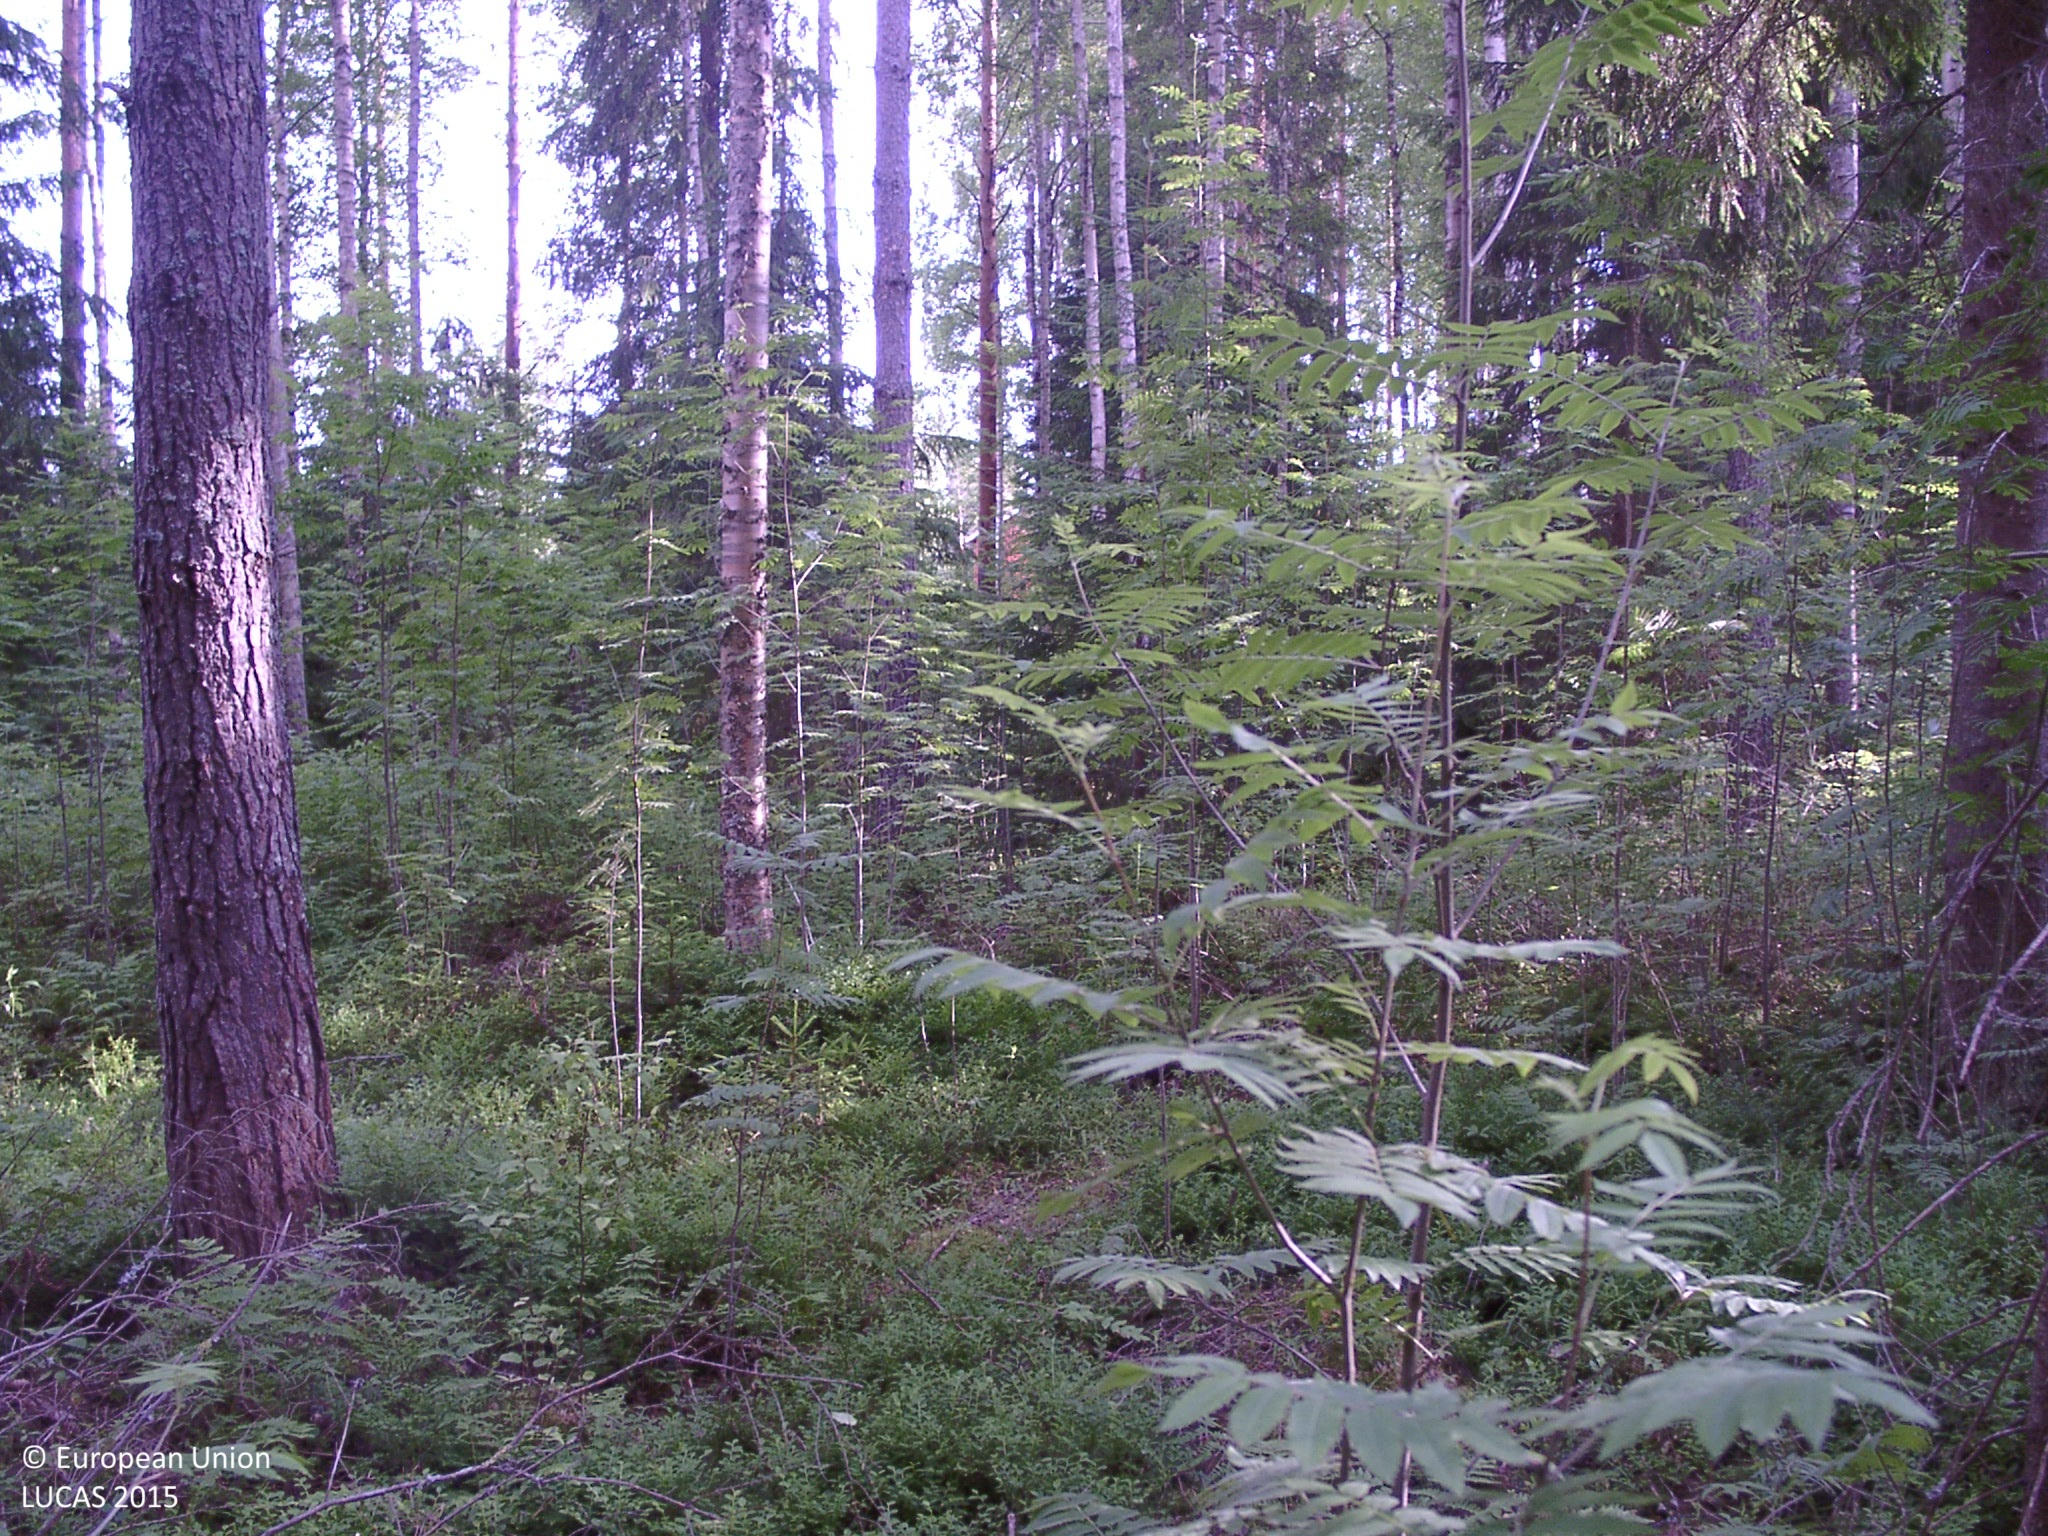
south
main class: Woodland
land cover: Other mixed woodland
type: boreal forest
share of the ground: 50 - 75 %
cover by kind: coniferous forest trees 35 %, broadleaved forest trees 35 %, shrubs 30 %
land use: Semi-natural and natural areas not in use
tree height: > 5 m
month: July
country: FI
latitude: 62.0180
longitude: 25.3784
